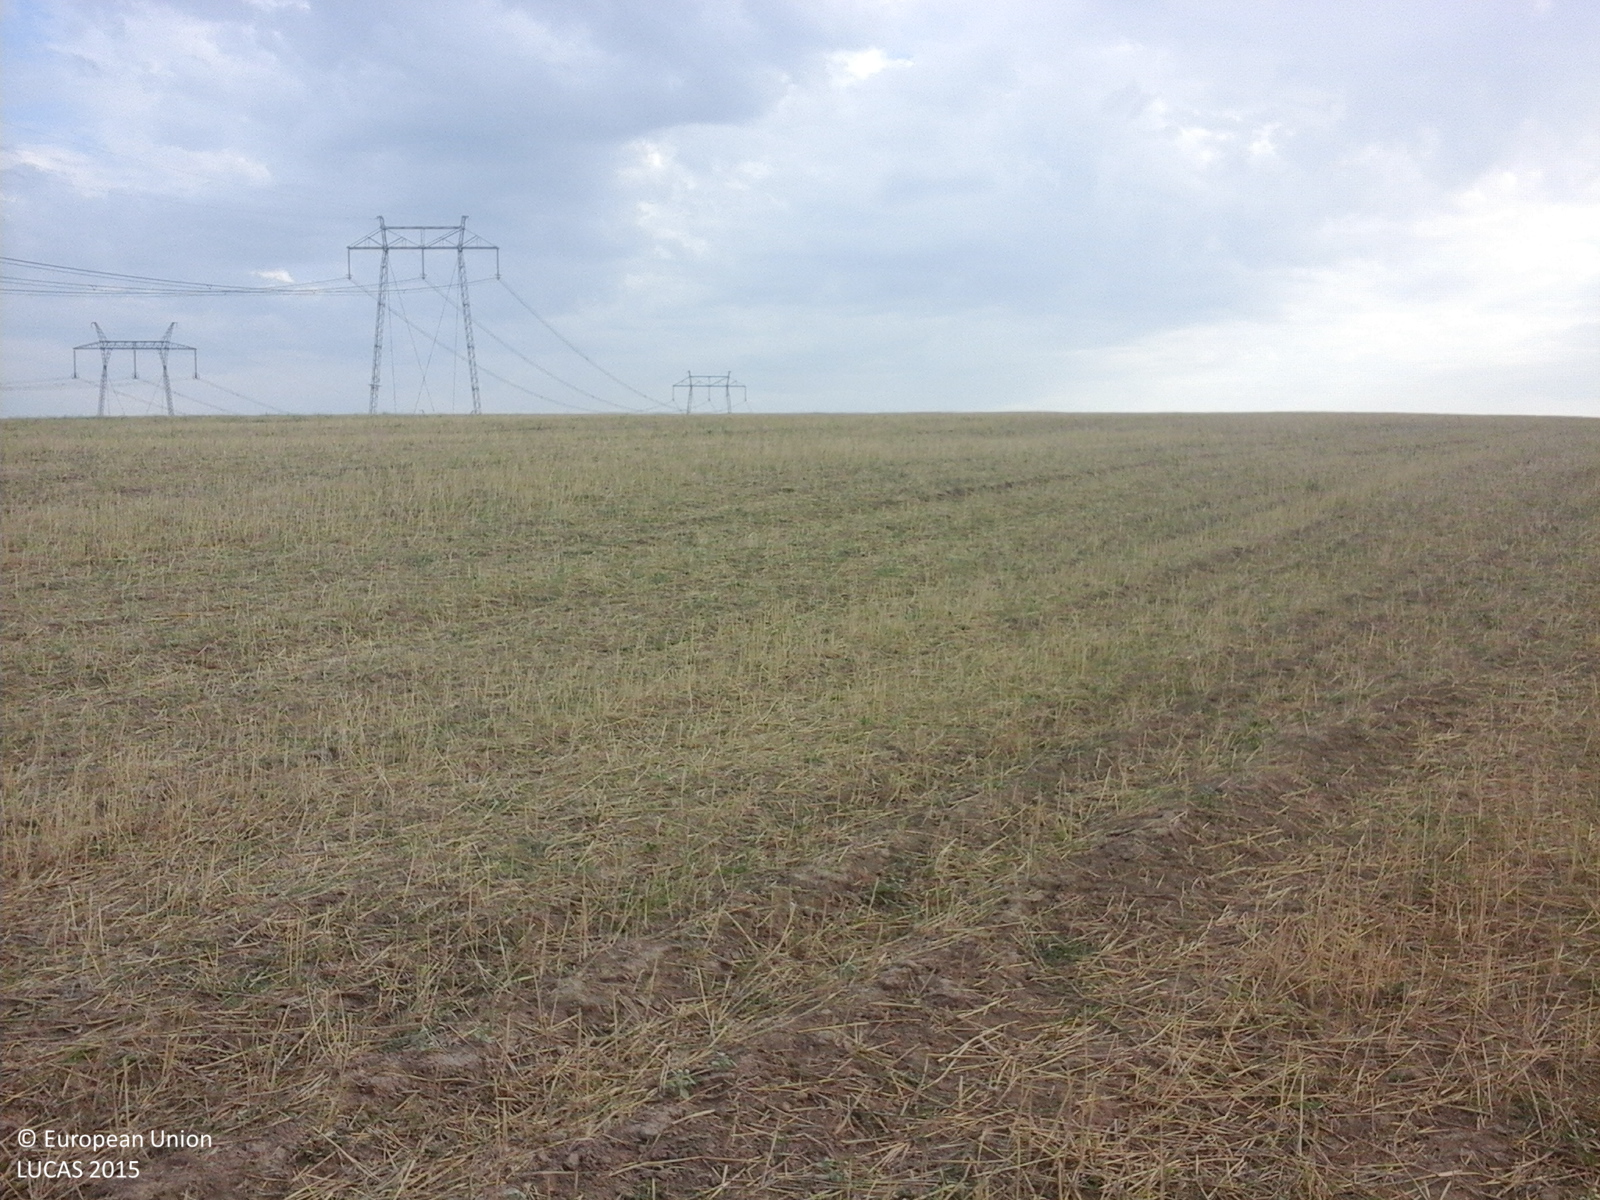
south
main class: Cropland
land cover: Common wheat
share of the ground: 25 - 50 %
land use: Agriculture (excluding fallow land and kitchen gardens)
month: August
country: RO
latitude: 44.3763
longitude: 28.1458
